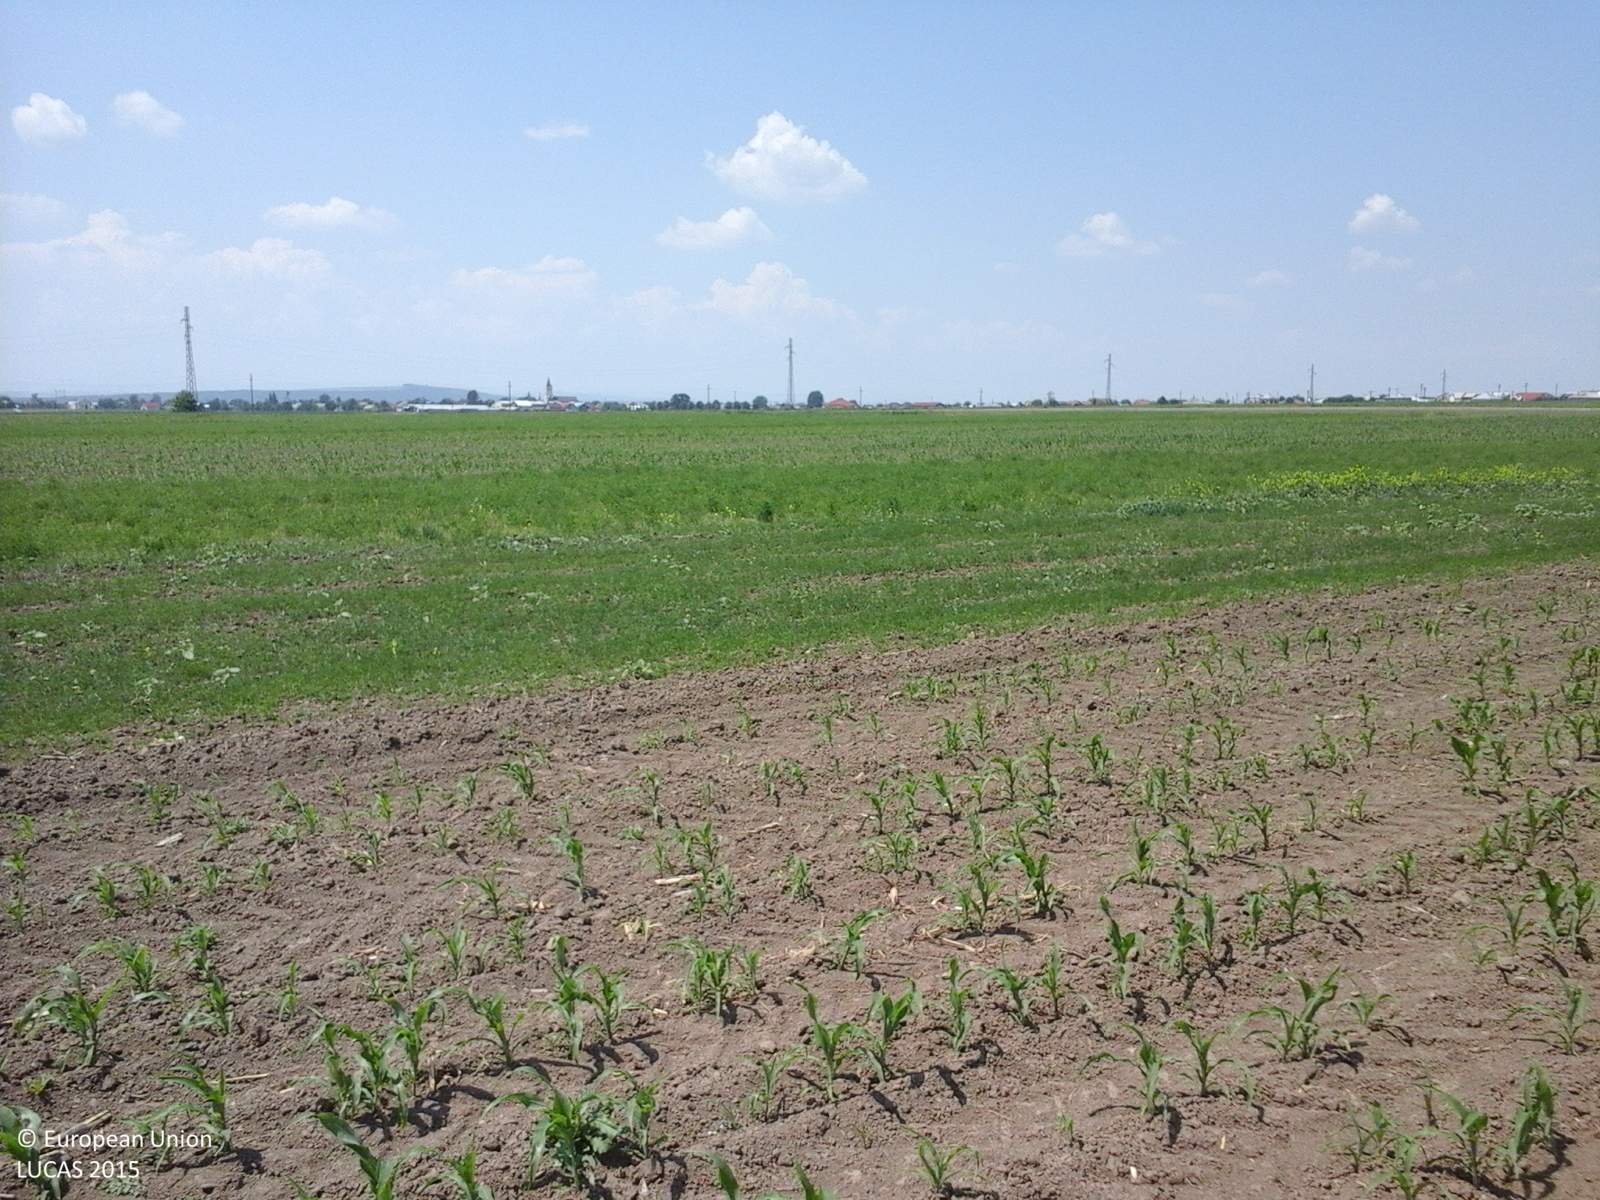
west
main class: Cropland
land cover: Maize
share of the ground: 25 - 50 %
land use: Agriculture (excluding fallow land and kitchen gardens)
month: June
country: RO
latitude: 47.0426
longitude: 26.8503
